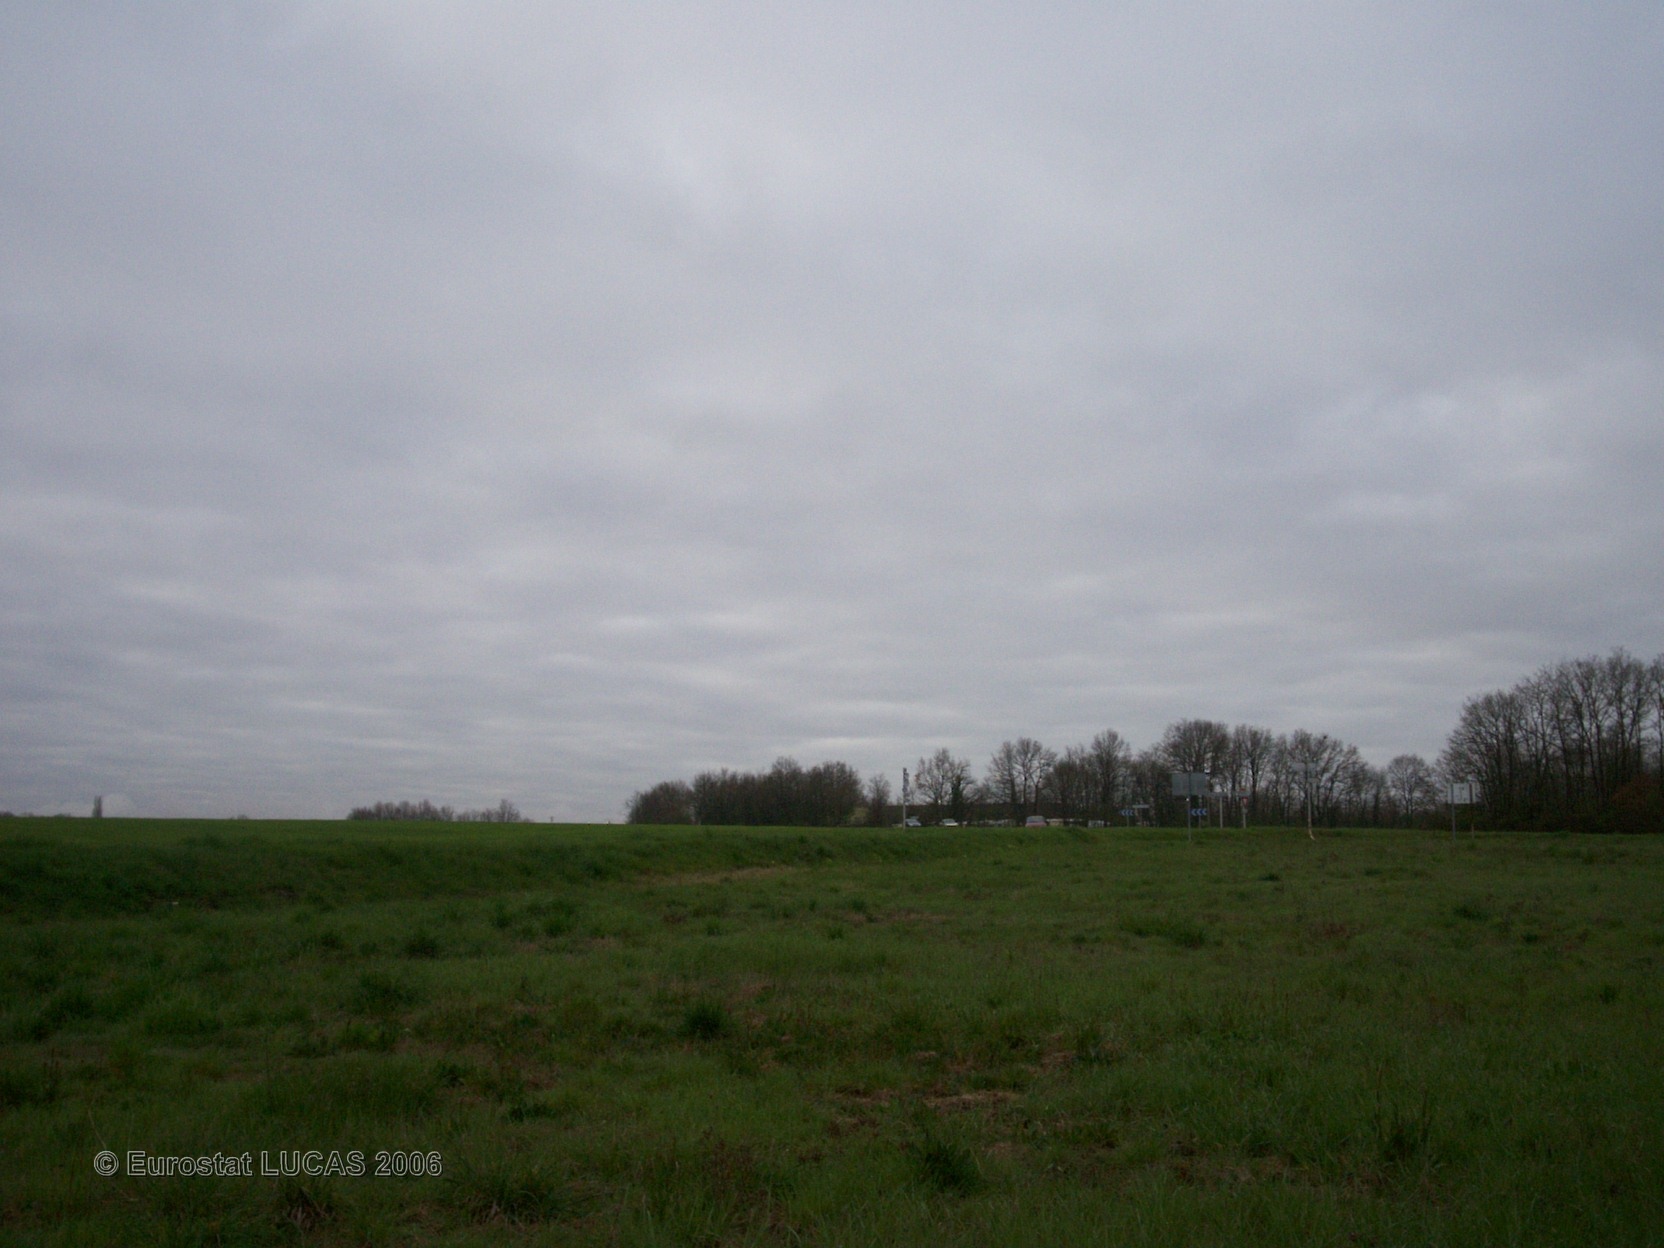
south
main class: Grassland
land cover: Grassland without tree/shrub cover
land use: Agriculture (excluding fallow land and kitchen gardens)
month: April
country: FR
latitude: 46.5348
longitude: 0.3982
